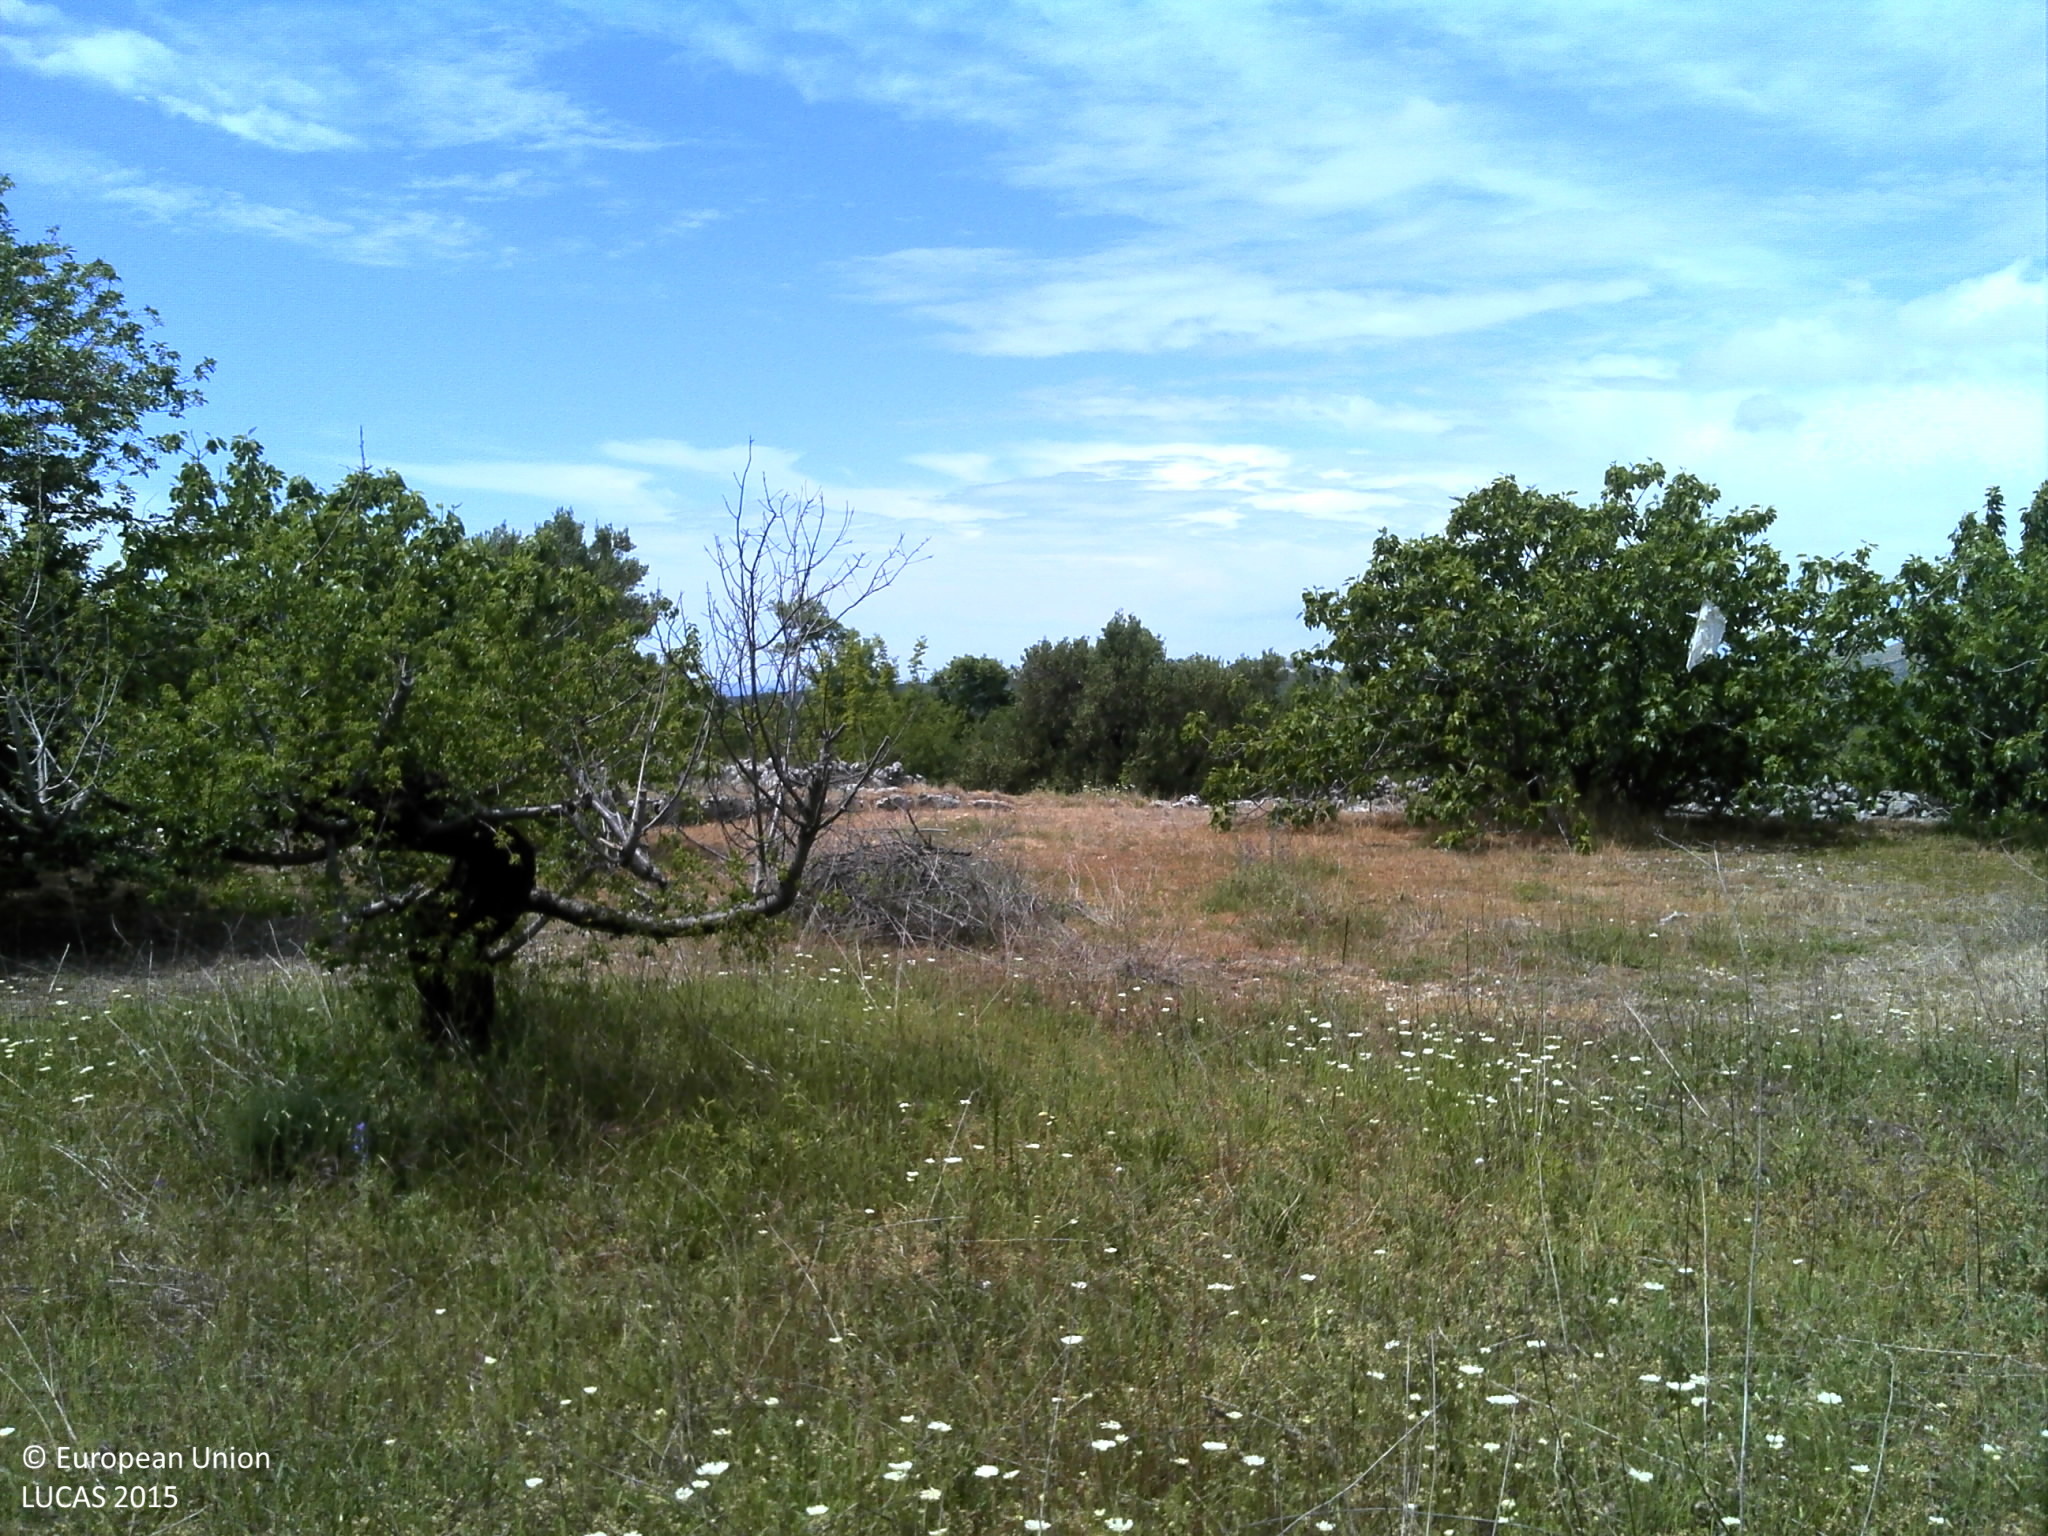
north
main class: Cropland
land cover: Cherry fruit
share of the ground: < 10 %
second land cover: Grassland without tree/shrub cover
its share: > 75 %
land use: Agriculture (excluding fallow land and kitchen gardens)
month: May
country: HR
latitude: 43.5788
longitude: 16.0214
